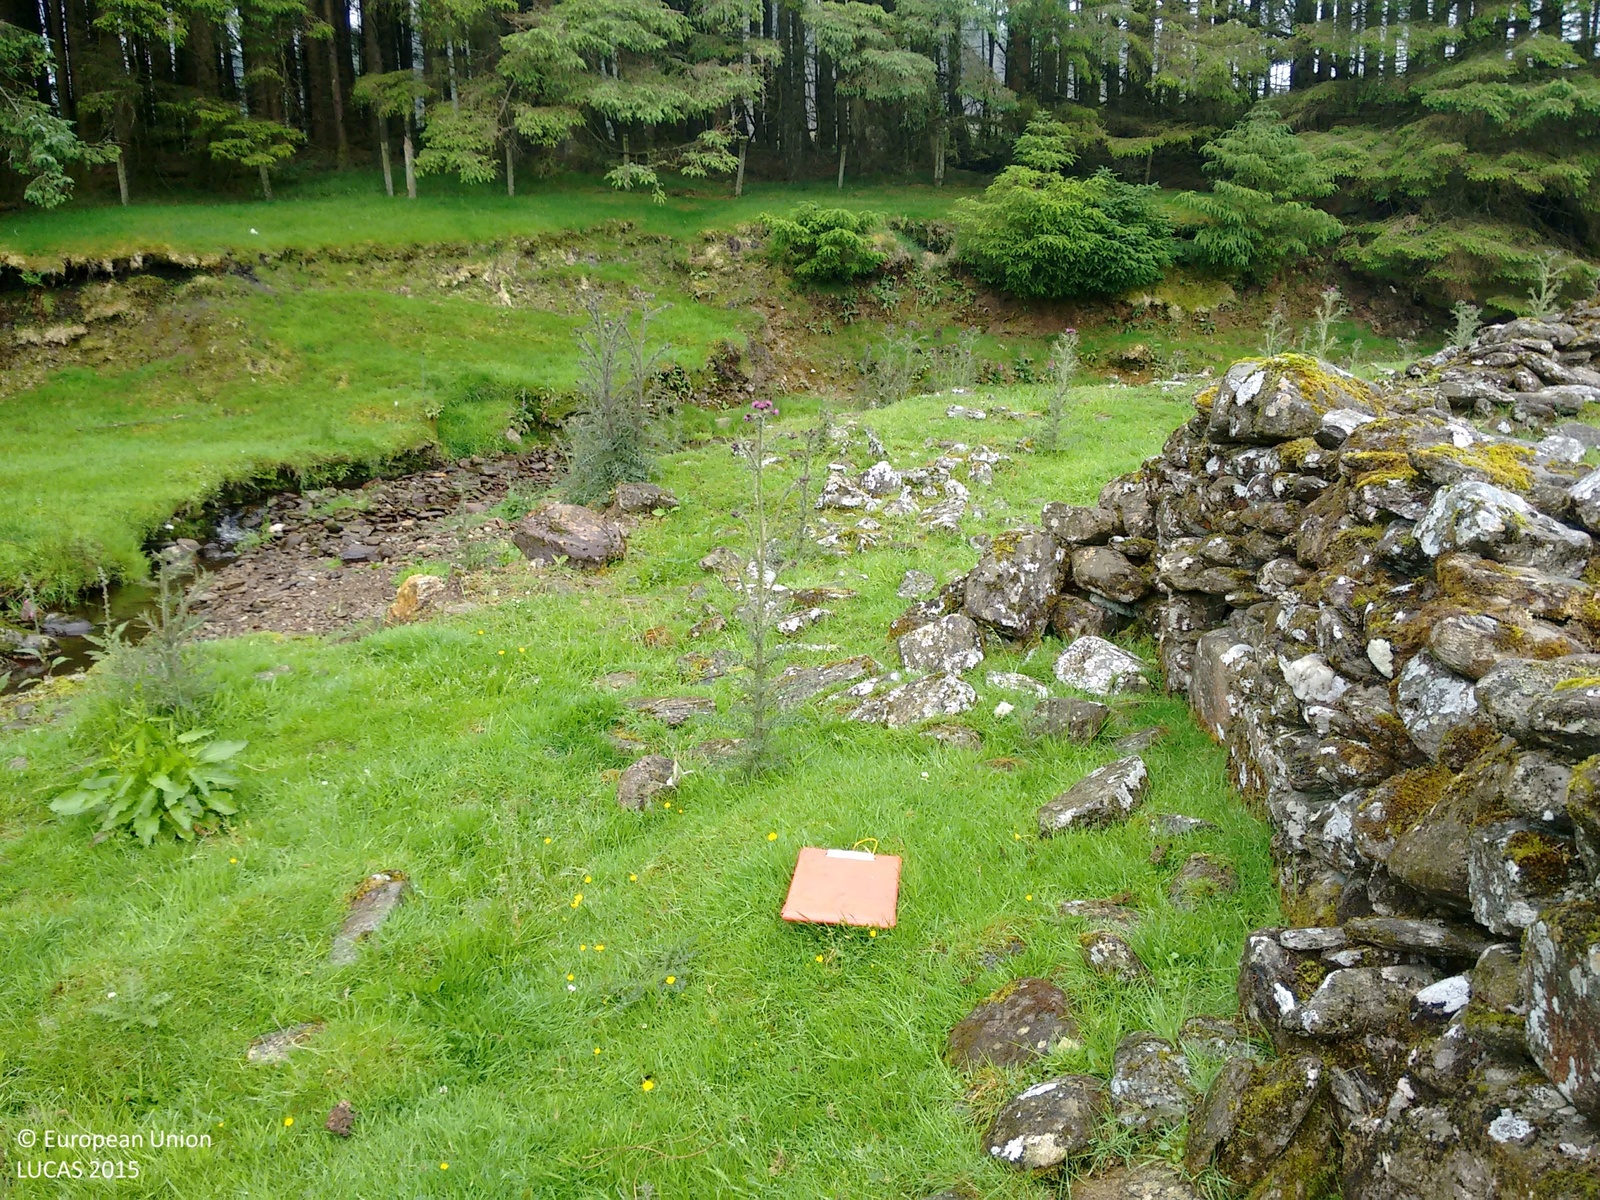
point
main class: Grassland
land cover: Grassland without tree/shrub cover
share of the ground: > 75 %
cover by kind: herbaceous plants 100 %
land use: Agriculture (excluding fallow land and kitchen gardens)
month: July
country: GB
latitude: 54.7897
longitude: -6.9483
